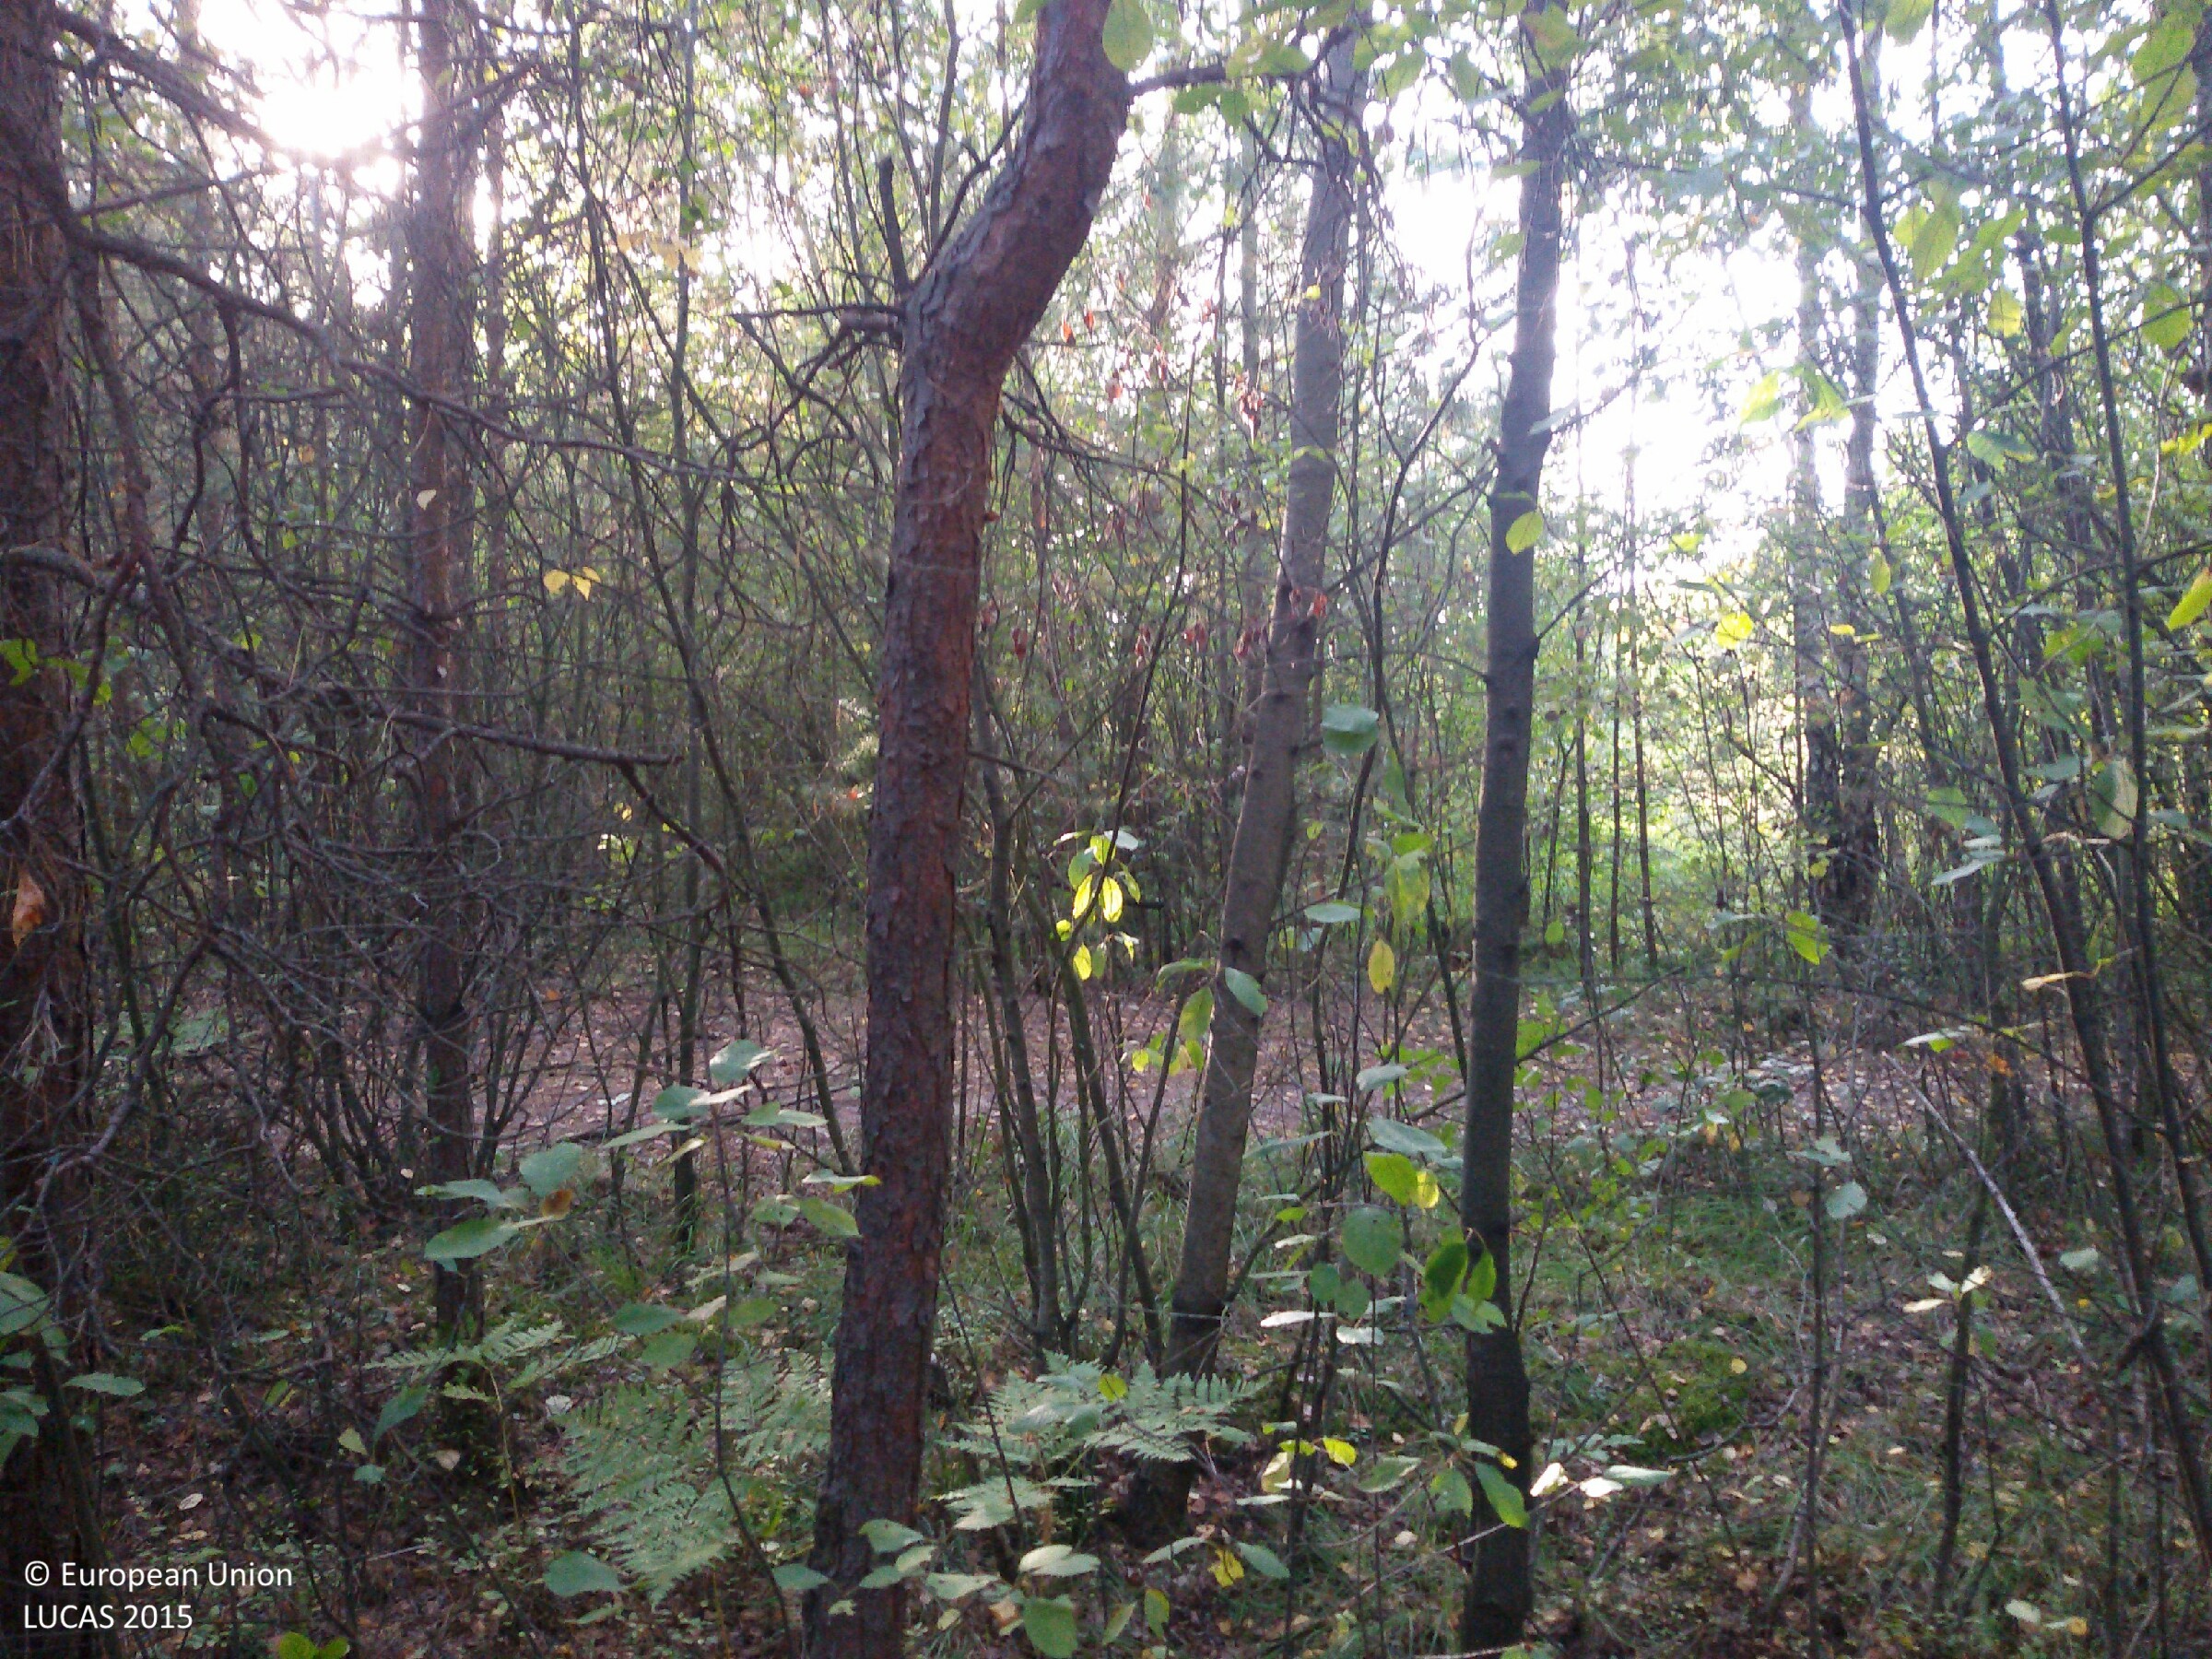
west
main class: Woodland
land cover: Pine dominated mixed woodland
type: hemiboreal forest and nemoral coniferous forest and mixed broadleaved-coniferous forest
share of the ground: > 75 %
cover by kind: coniferous forest trees 75 %, broadleaved forest trees 25 %
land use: Forestry
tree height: > 5 m
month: September
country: PL
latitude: 51.2370
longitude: 19.6978
